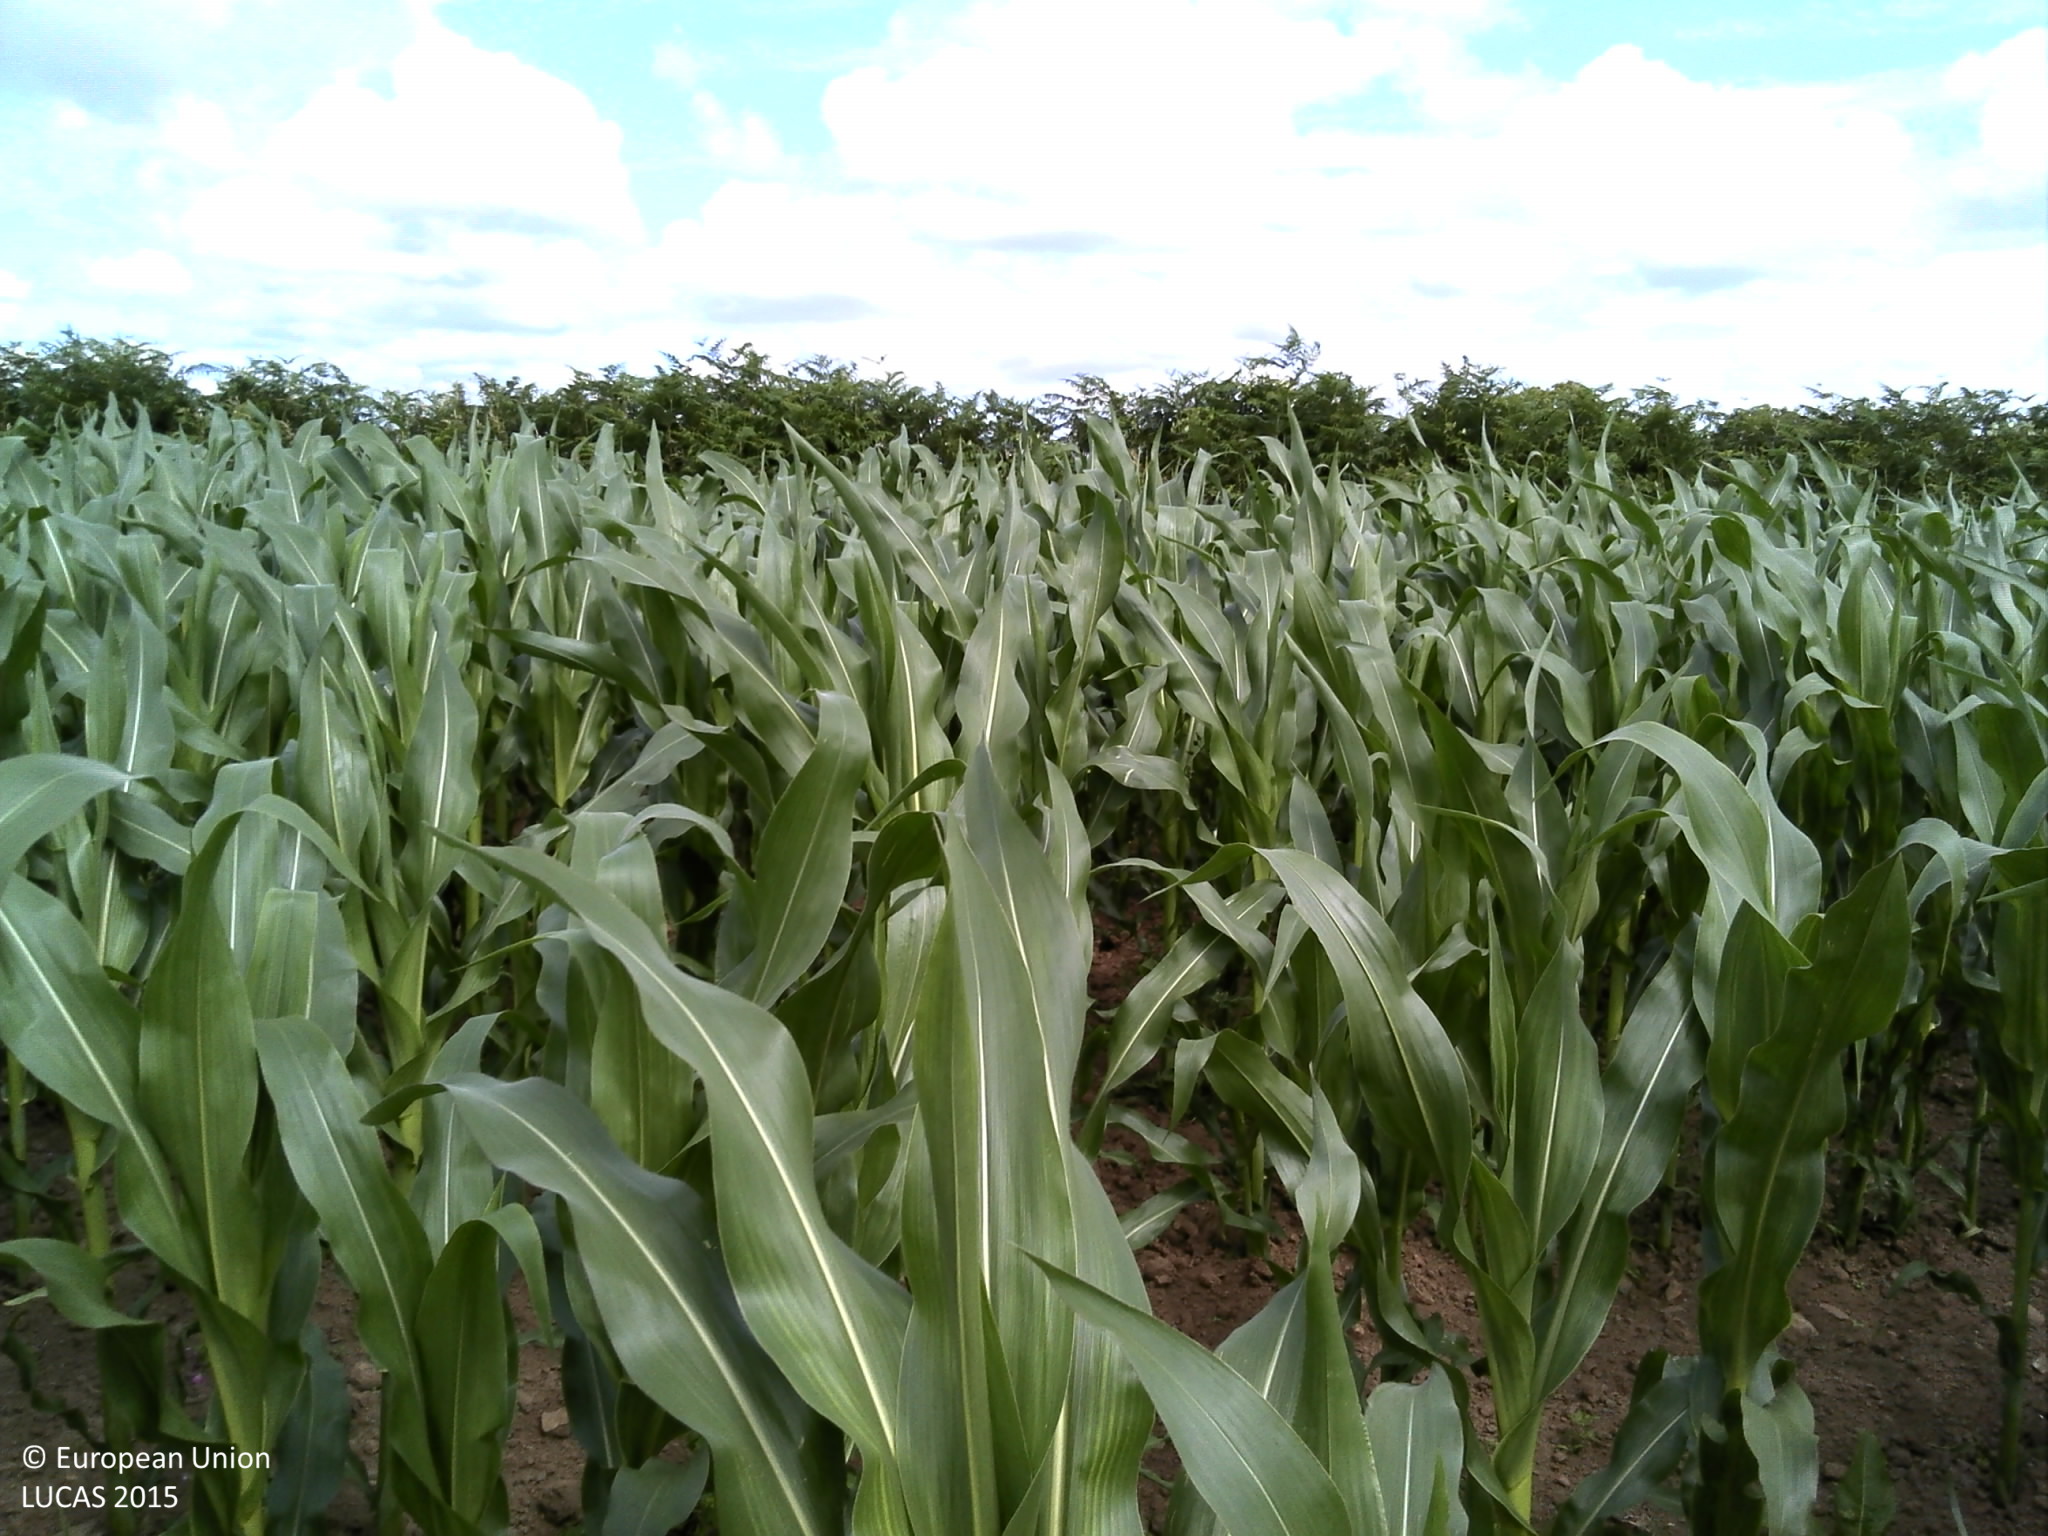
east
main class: Cropland
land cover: Maize
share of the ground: > 75 %
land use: Agriculture (excluding fallow land and kitchen gardens)
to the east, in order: Maize; Managed hedges; Maize; Managed hedges; Tracks; Managed hedges; Maize
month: July
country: FR
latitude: 48.4539
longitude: -4.5821
